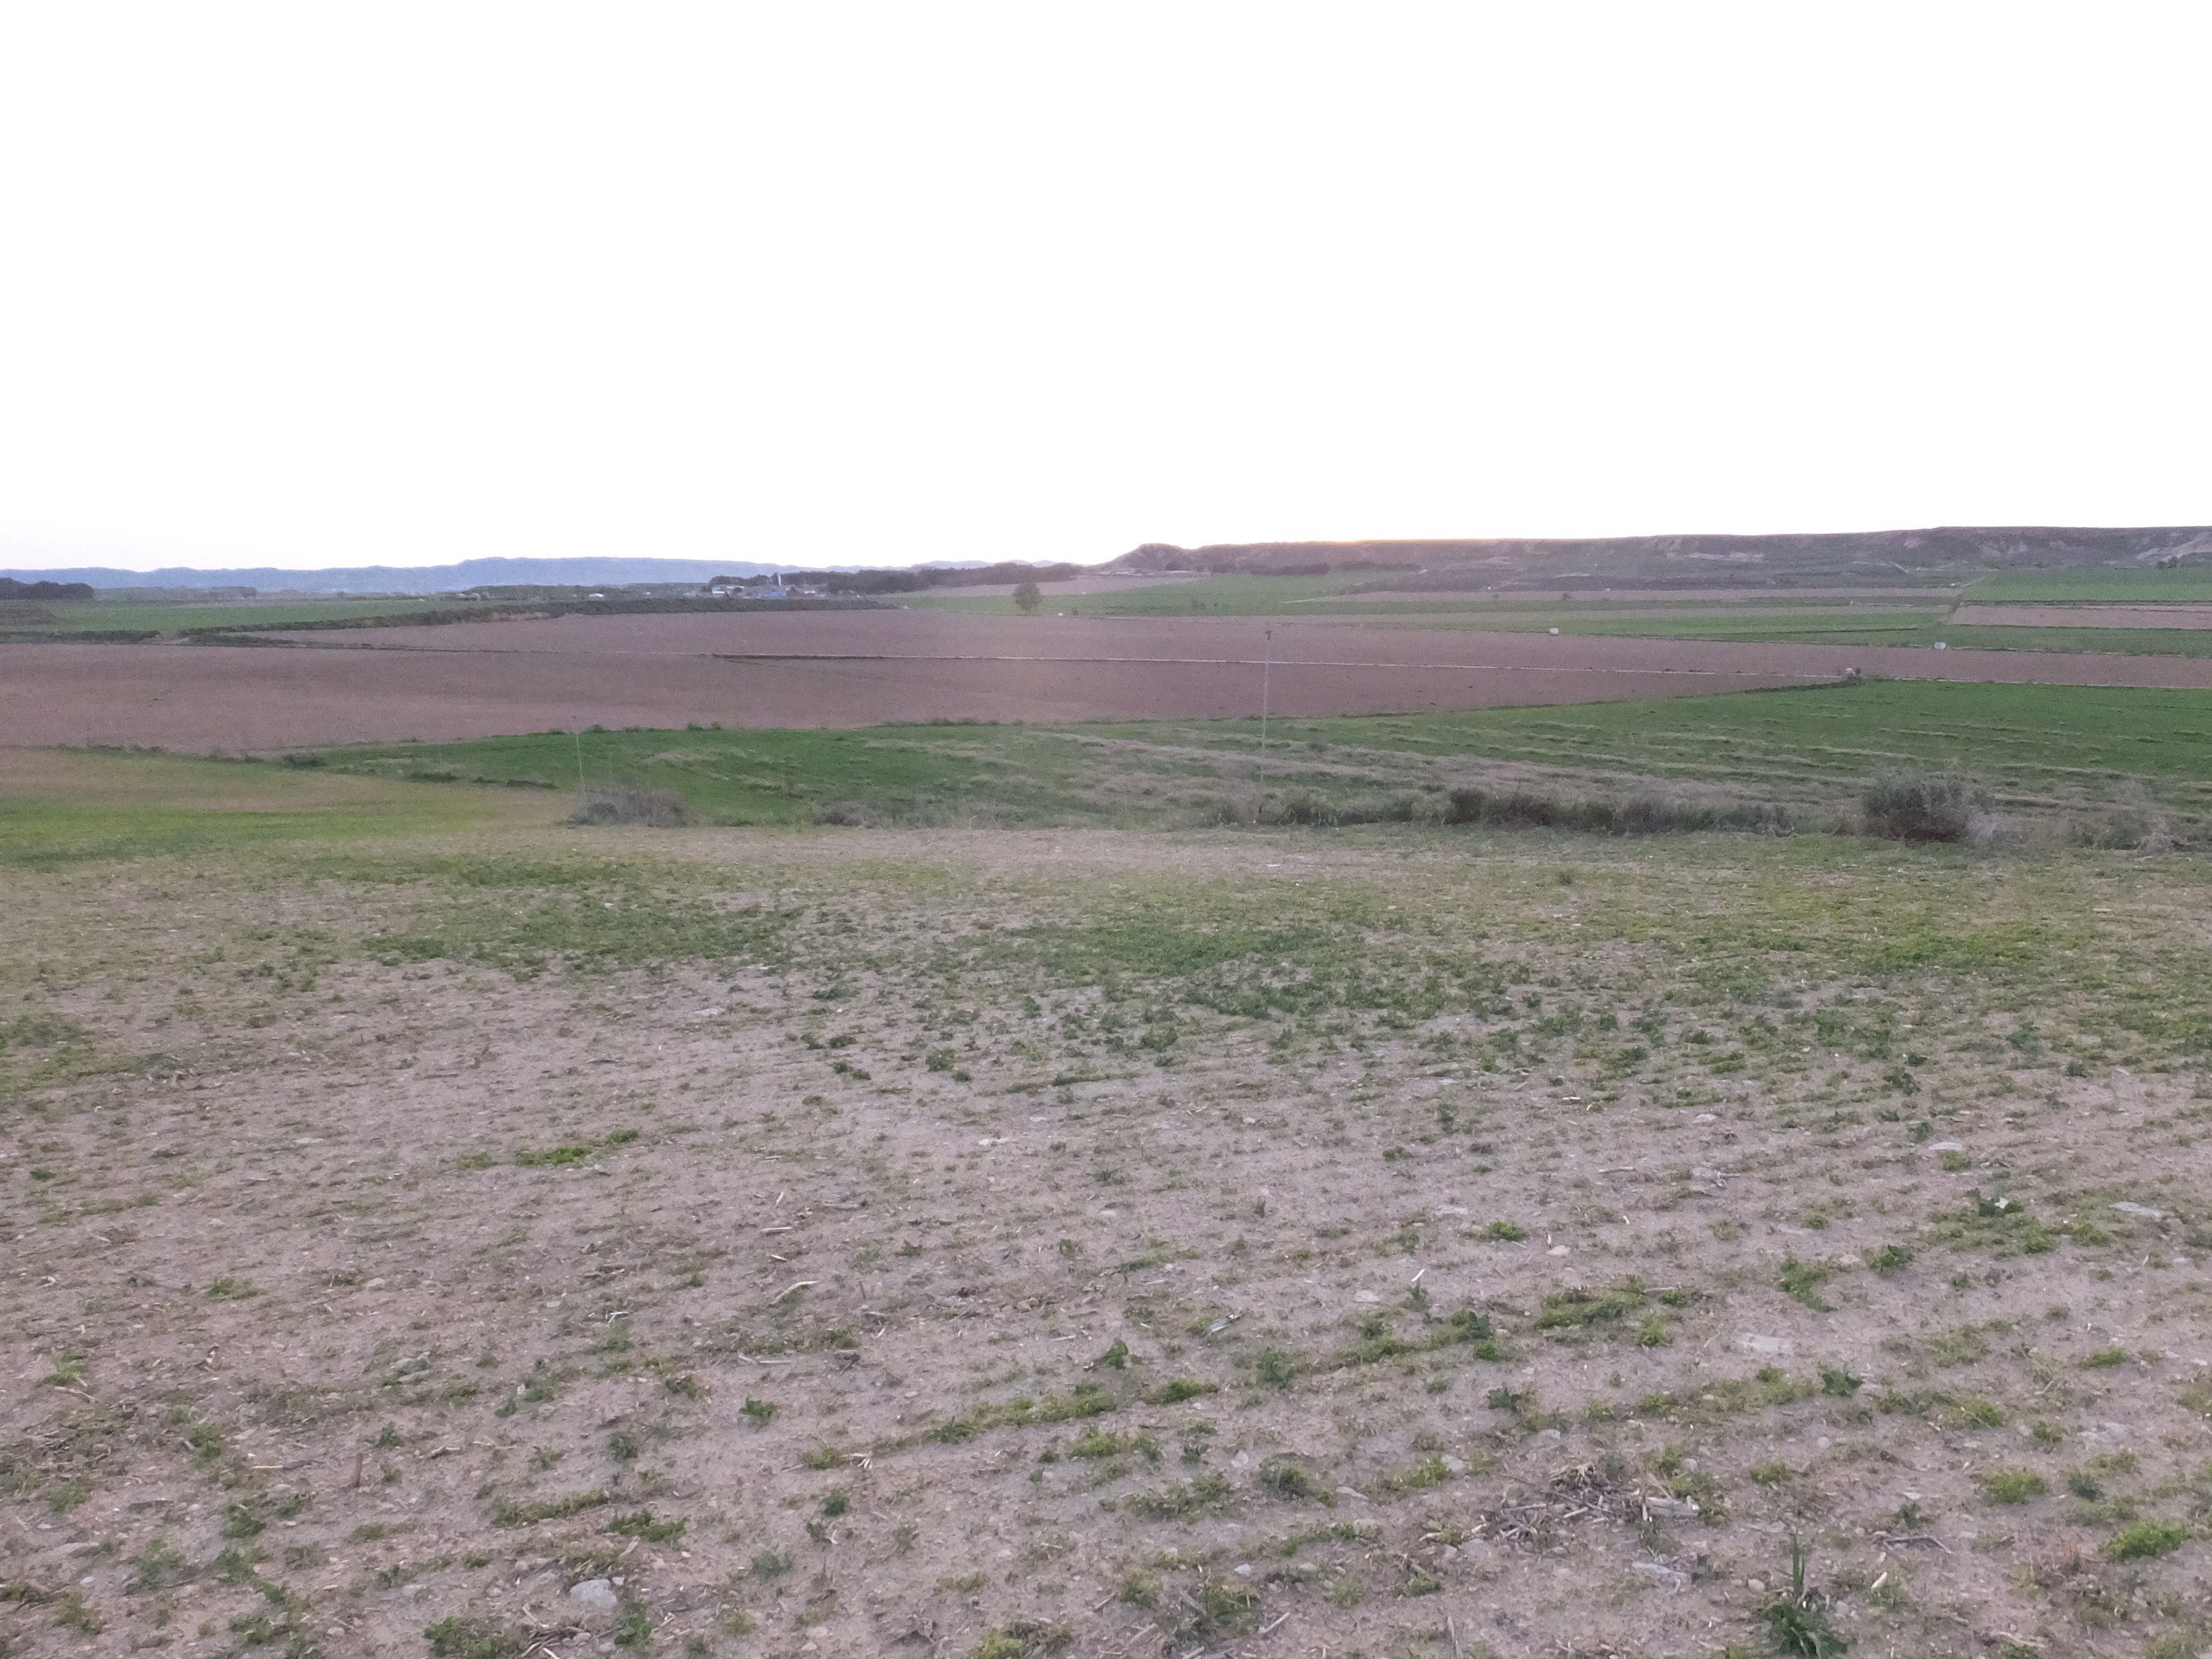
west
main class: Cropland
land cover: Lucerne
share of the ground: > 75 %
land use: Agriculture (excluding fallow land and kitchen gardens)
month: April
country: ES
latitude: 41.8324
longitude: -0.3388
